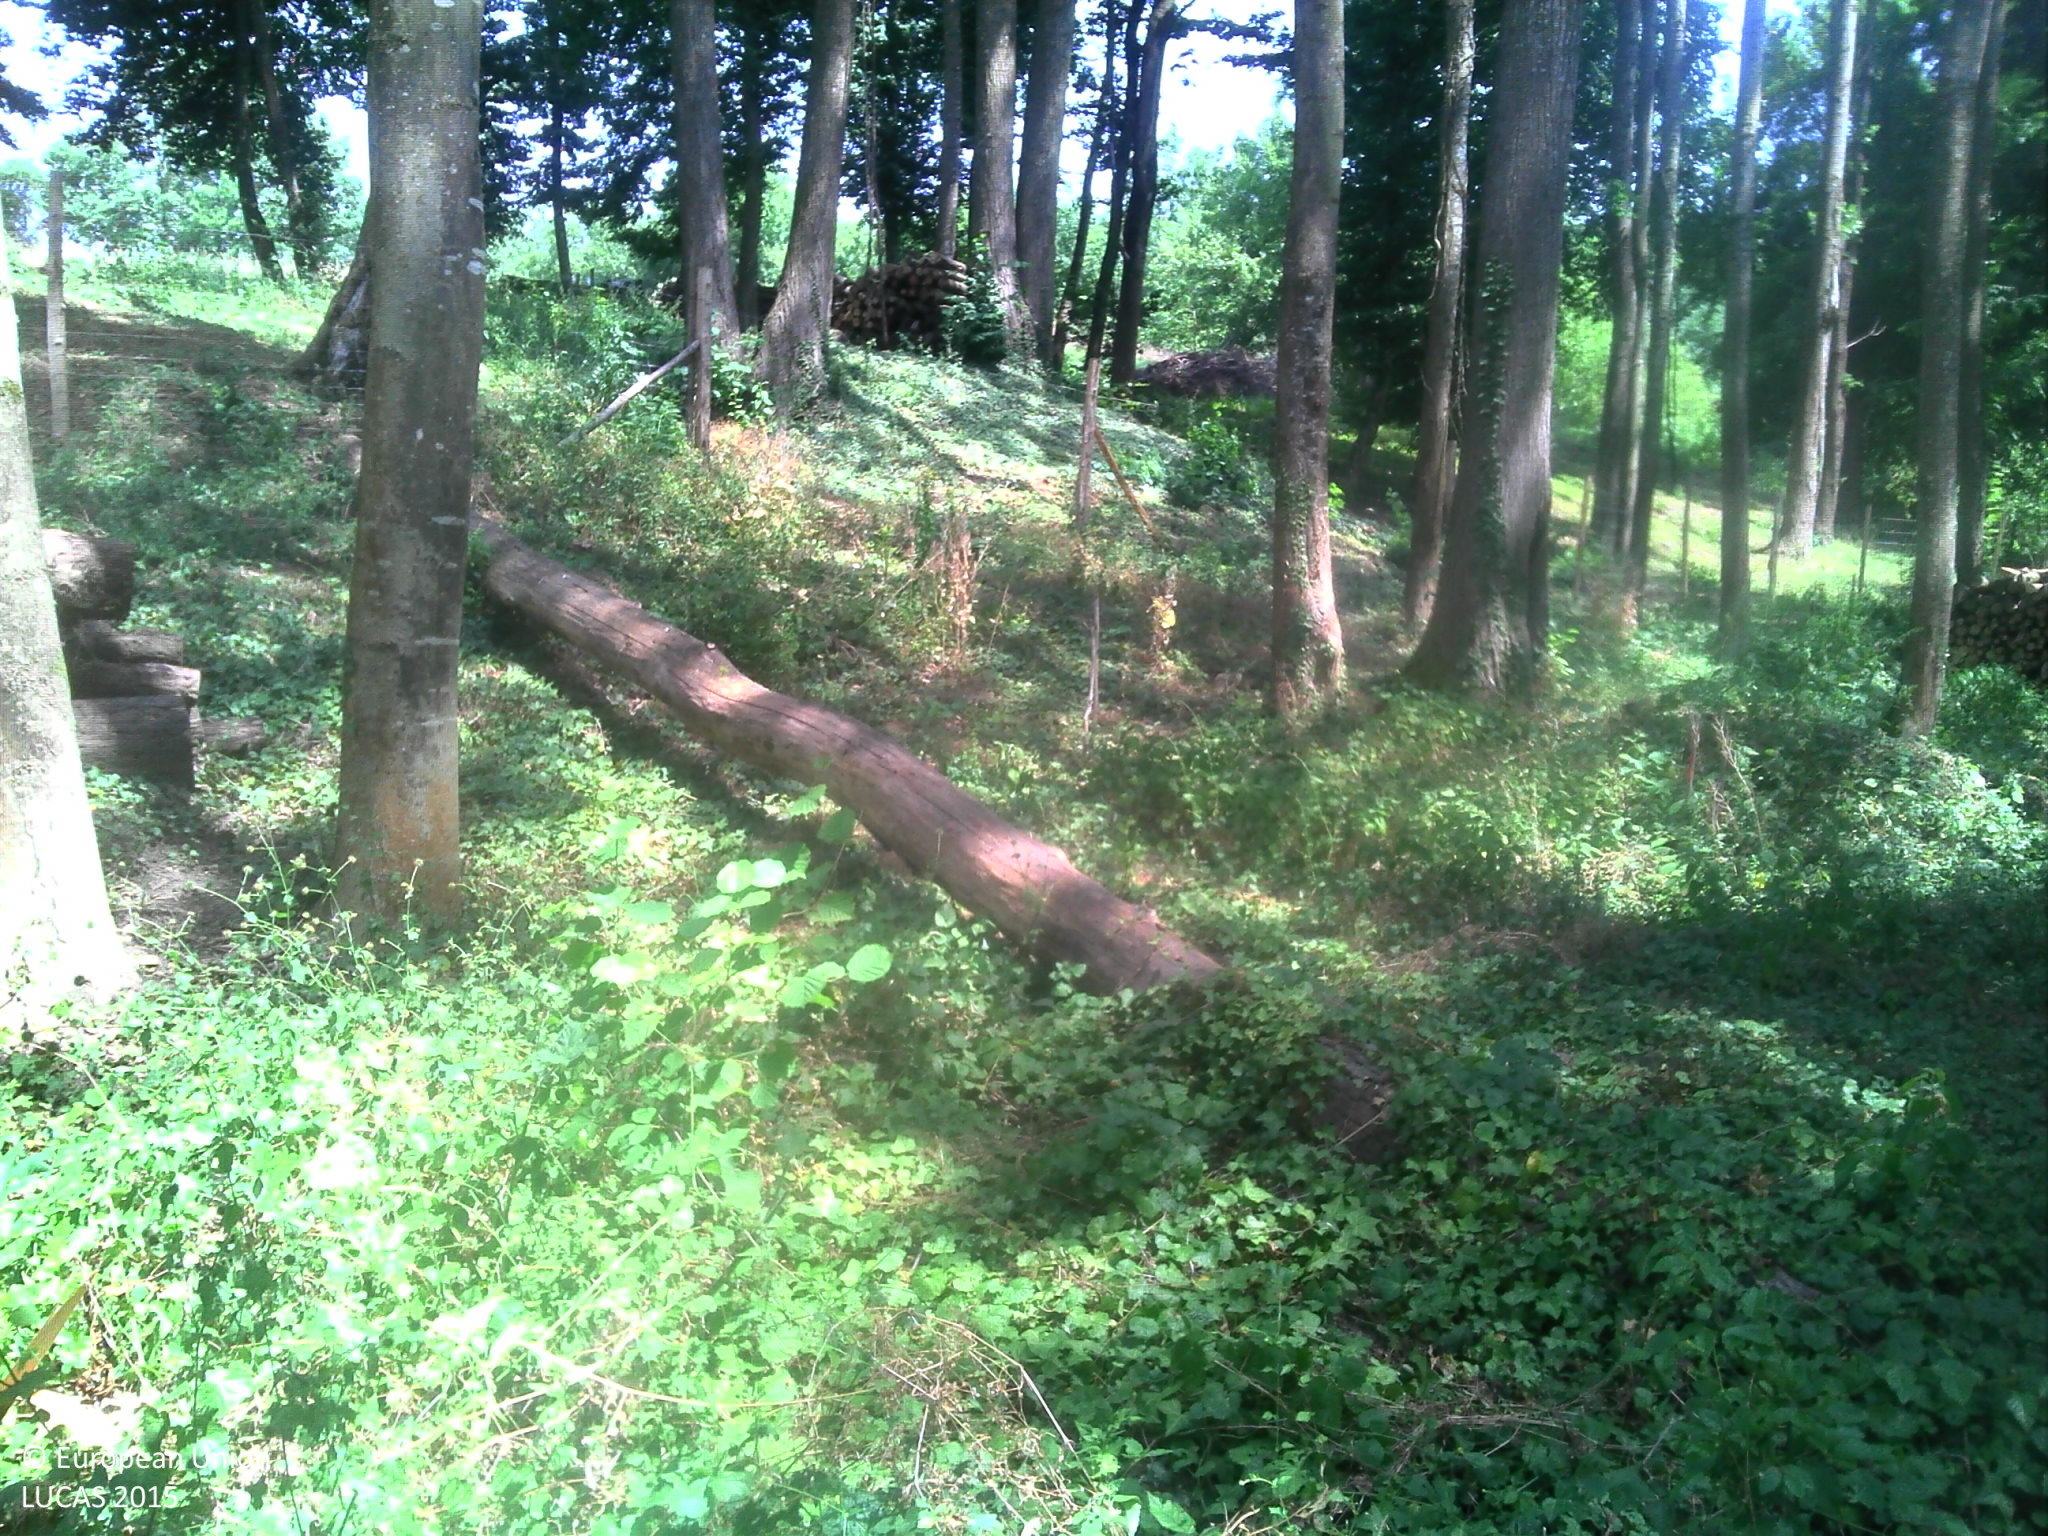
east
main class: Woodland
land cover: Broadleaved woodland
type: mesophytic deciduous forest
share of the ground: > 75 %
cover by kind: broadleaved forest trees 75 %, herbaceous plants 25 %
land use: Forestry
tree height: > 5 m
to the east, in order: Broadleaved woodland; Fences; Broadleaved woodland; Fences; Grassland without tree/shrub cover; Fences; Broadleaved woodland; Spontaneously vegetated surfaces
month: July
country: FR
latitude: 45.5519
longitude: 5.0727
